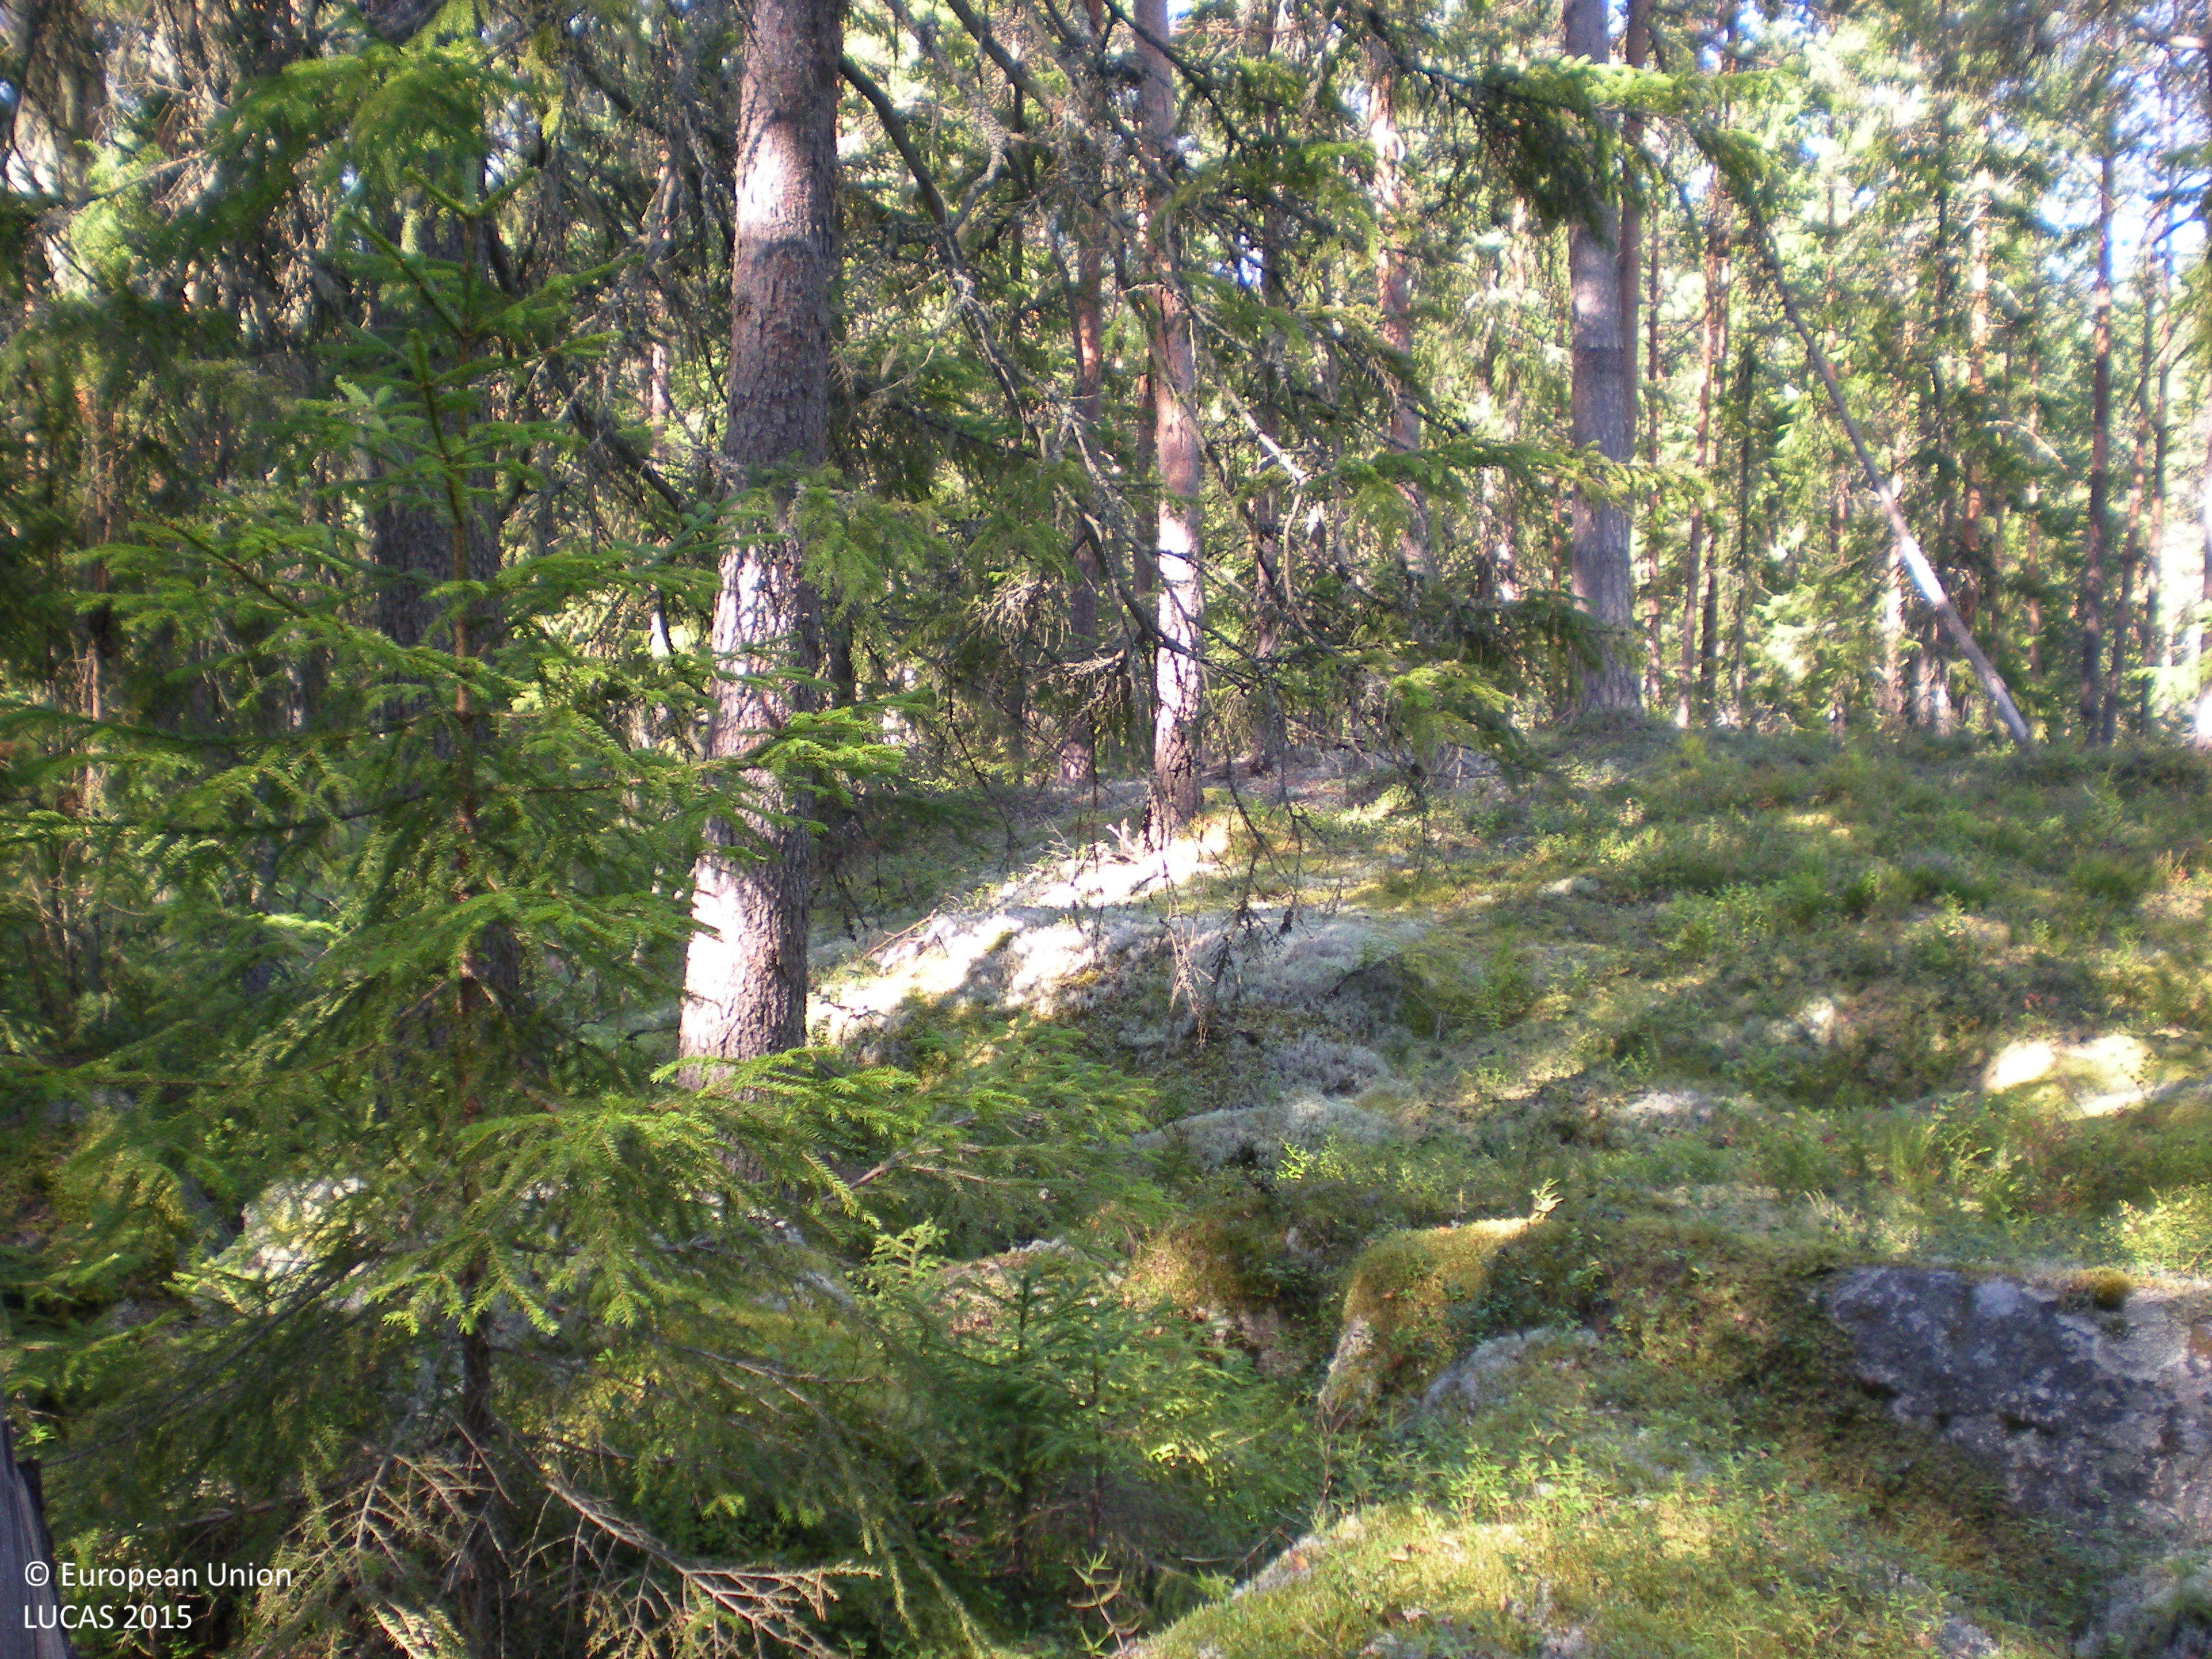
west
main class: Woodland
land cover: Other coniferous woodland
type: boreal forest
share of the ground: 50 - 75 %
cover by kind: coniferous forest trees 65 %, shrubs 20 %, lichens and mosses 15 %
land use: Forestry
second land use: Amenities, museums, leisure
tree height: > 5 m
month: August
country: SE
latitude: 60.5862
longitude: 17.3464
